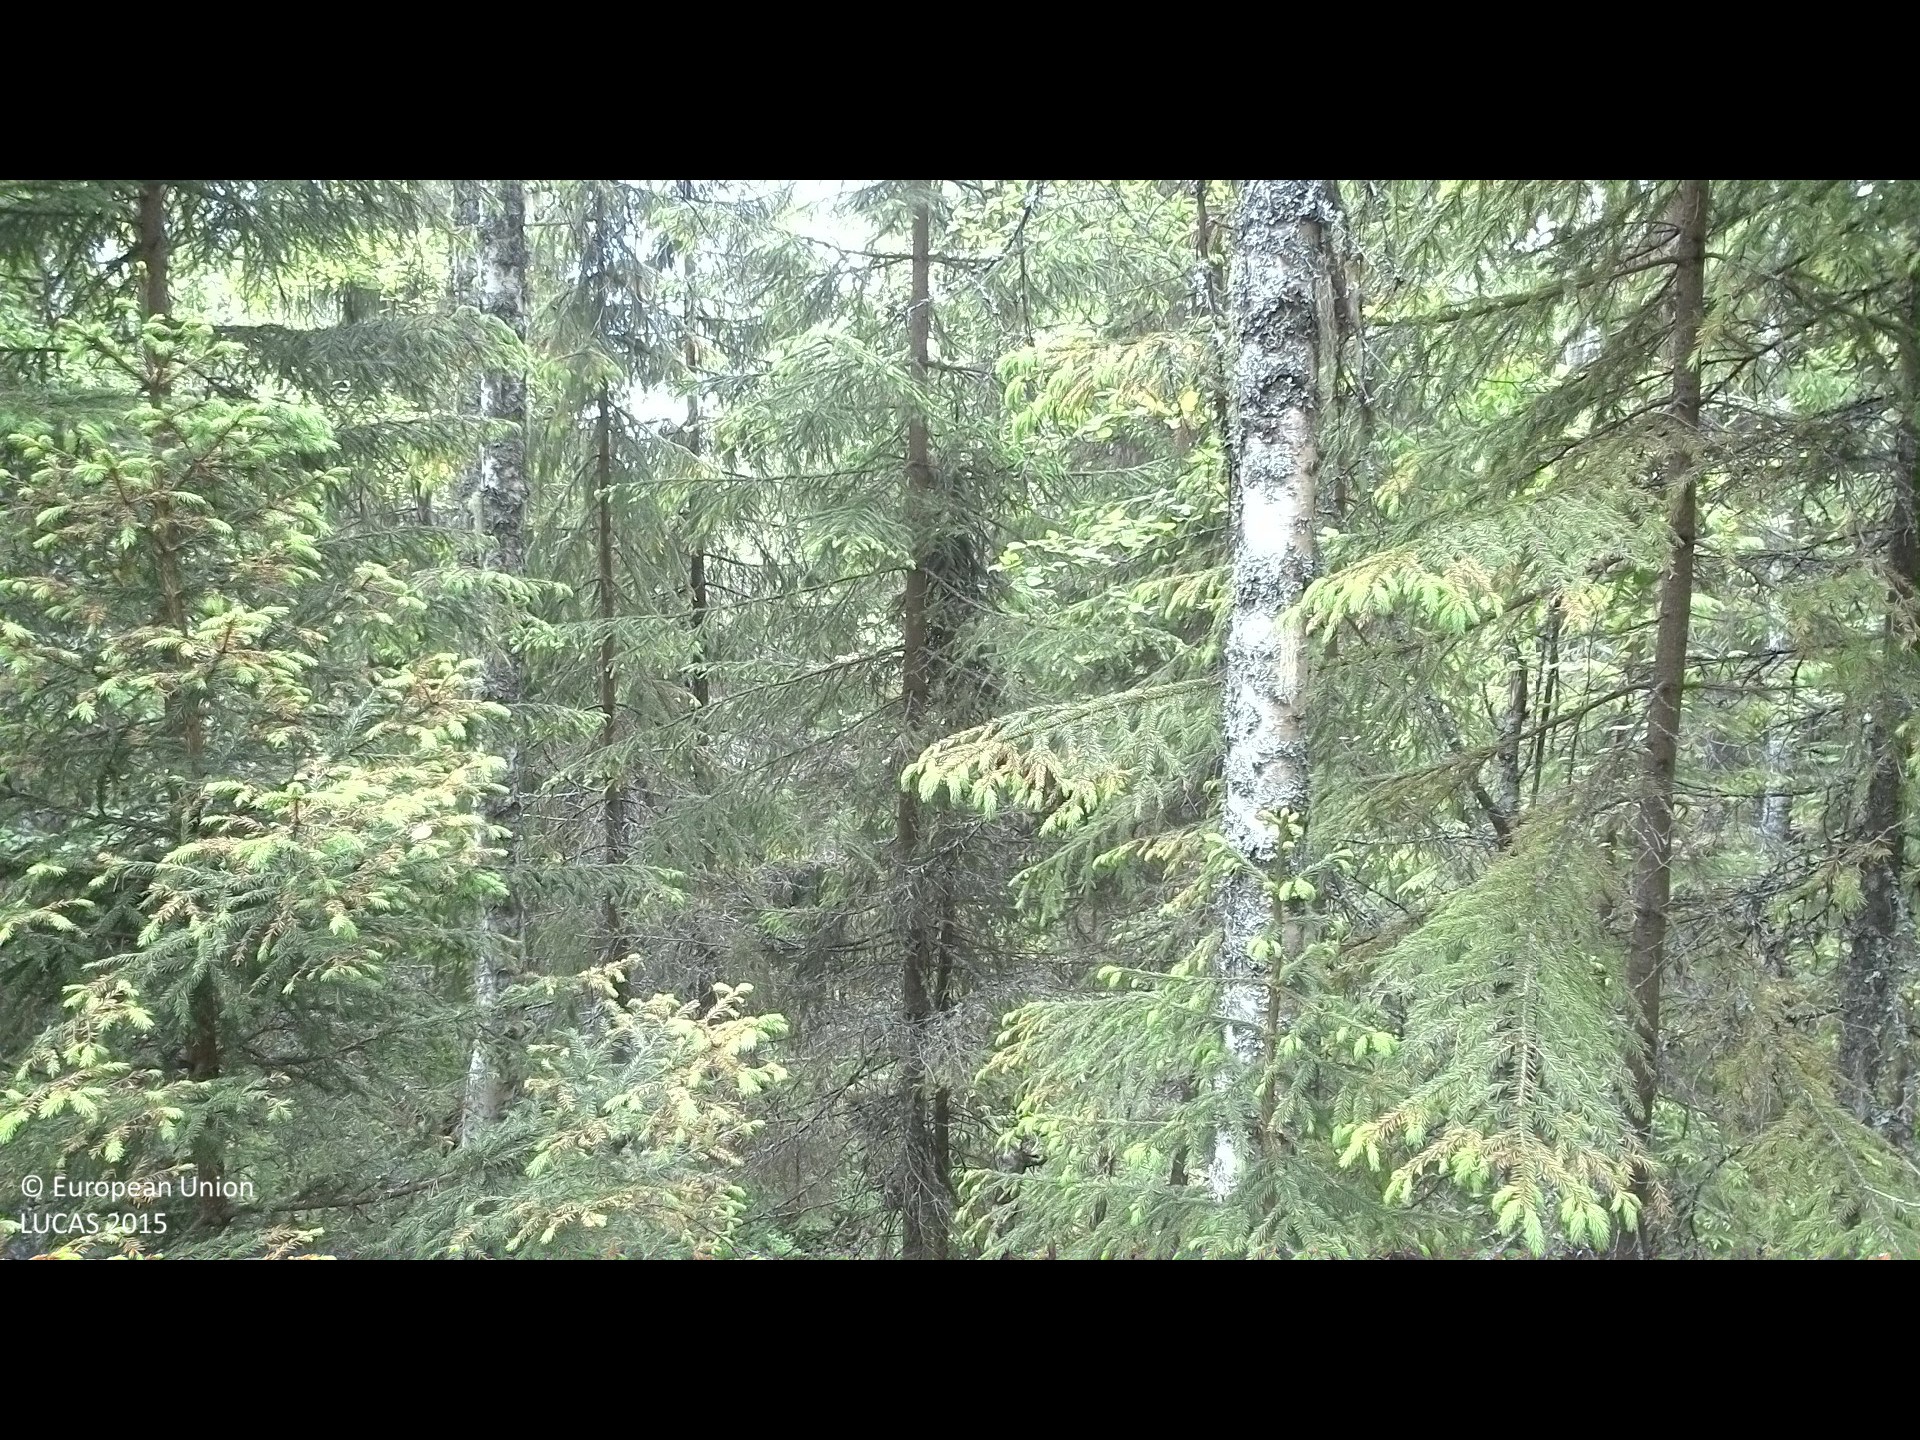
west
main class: Woodland
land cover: Spruce dominated mixed woodland
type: boreal forest
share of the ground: 25 - 50 %
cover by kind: lichens and mosses 35 %, shrubs 30 %, coniferous forest trees 20 %, broadleaved forest trees 15 %
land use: Forestry
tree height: > 5 m
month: June
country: SE
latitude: 61.9774
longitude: 16.2208
